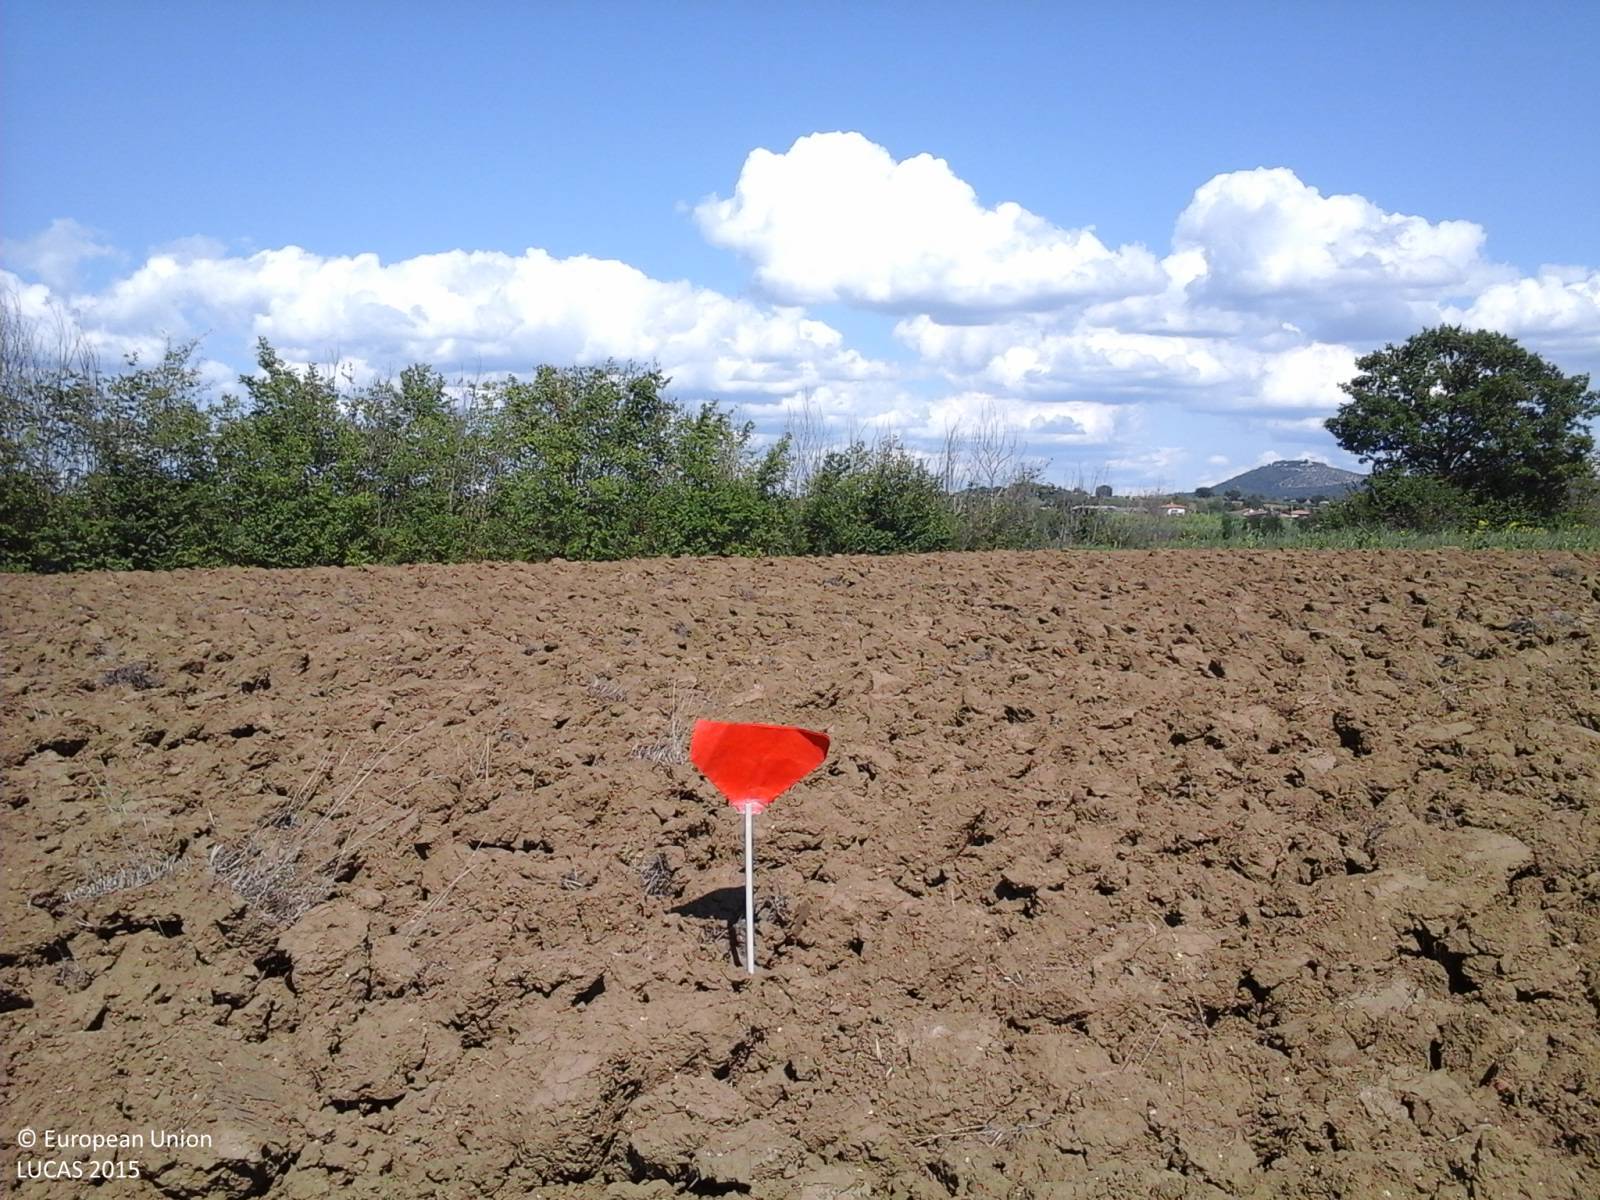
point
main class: Cropland
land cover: Durum wheat
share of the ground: < 10 %
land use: Agriculture (excluding fallow land and kitchen gardens)
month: September
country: IT
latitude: 43.0484
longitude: 12.0685
